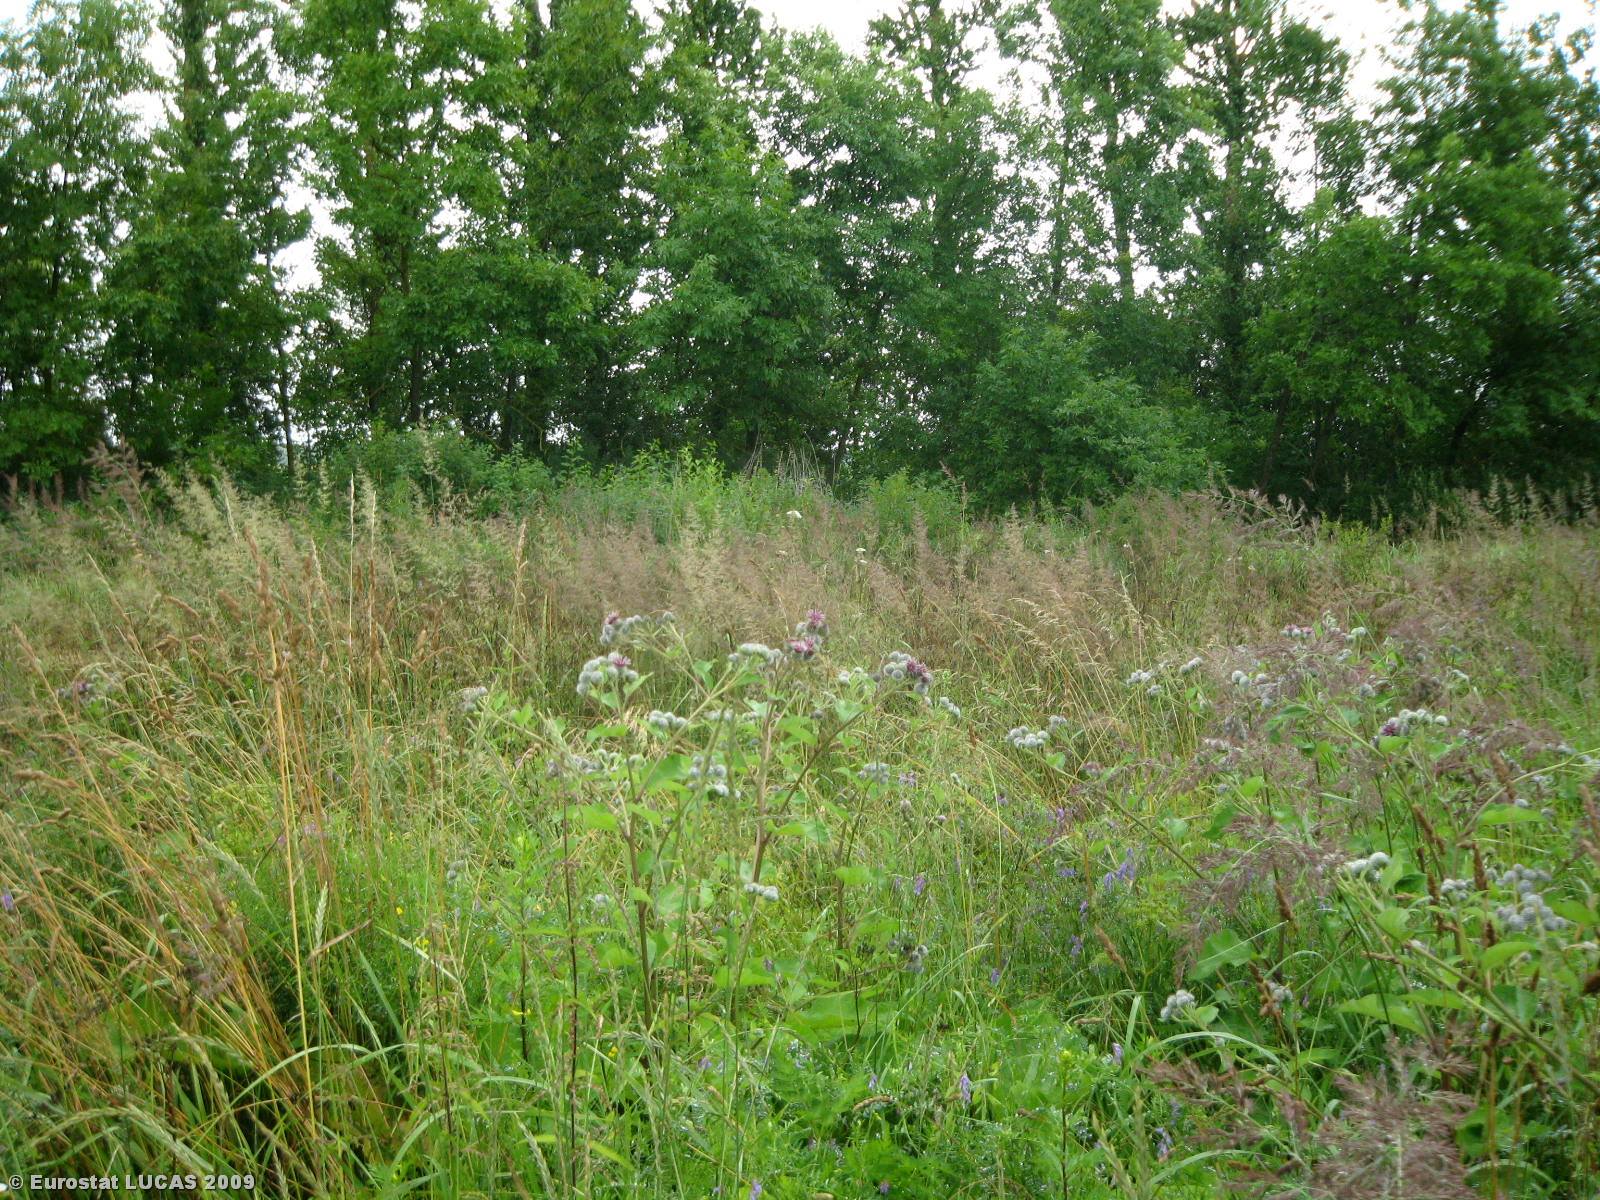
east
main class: Grassland
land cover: Grassland without tree/shrub cover
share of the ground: > 75 %
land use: Railway transport
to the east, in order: Grassland without tree/shrub cover; Paved roads, cycling and walking lanes; Grassland with sparse tree/shrub cover; Broadleaved woodland; Grassland without tree/shrub cover; Fences; Grassland without tree/shrub cover
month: July
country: LT
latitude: 55.5298
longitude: 23.7886
